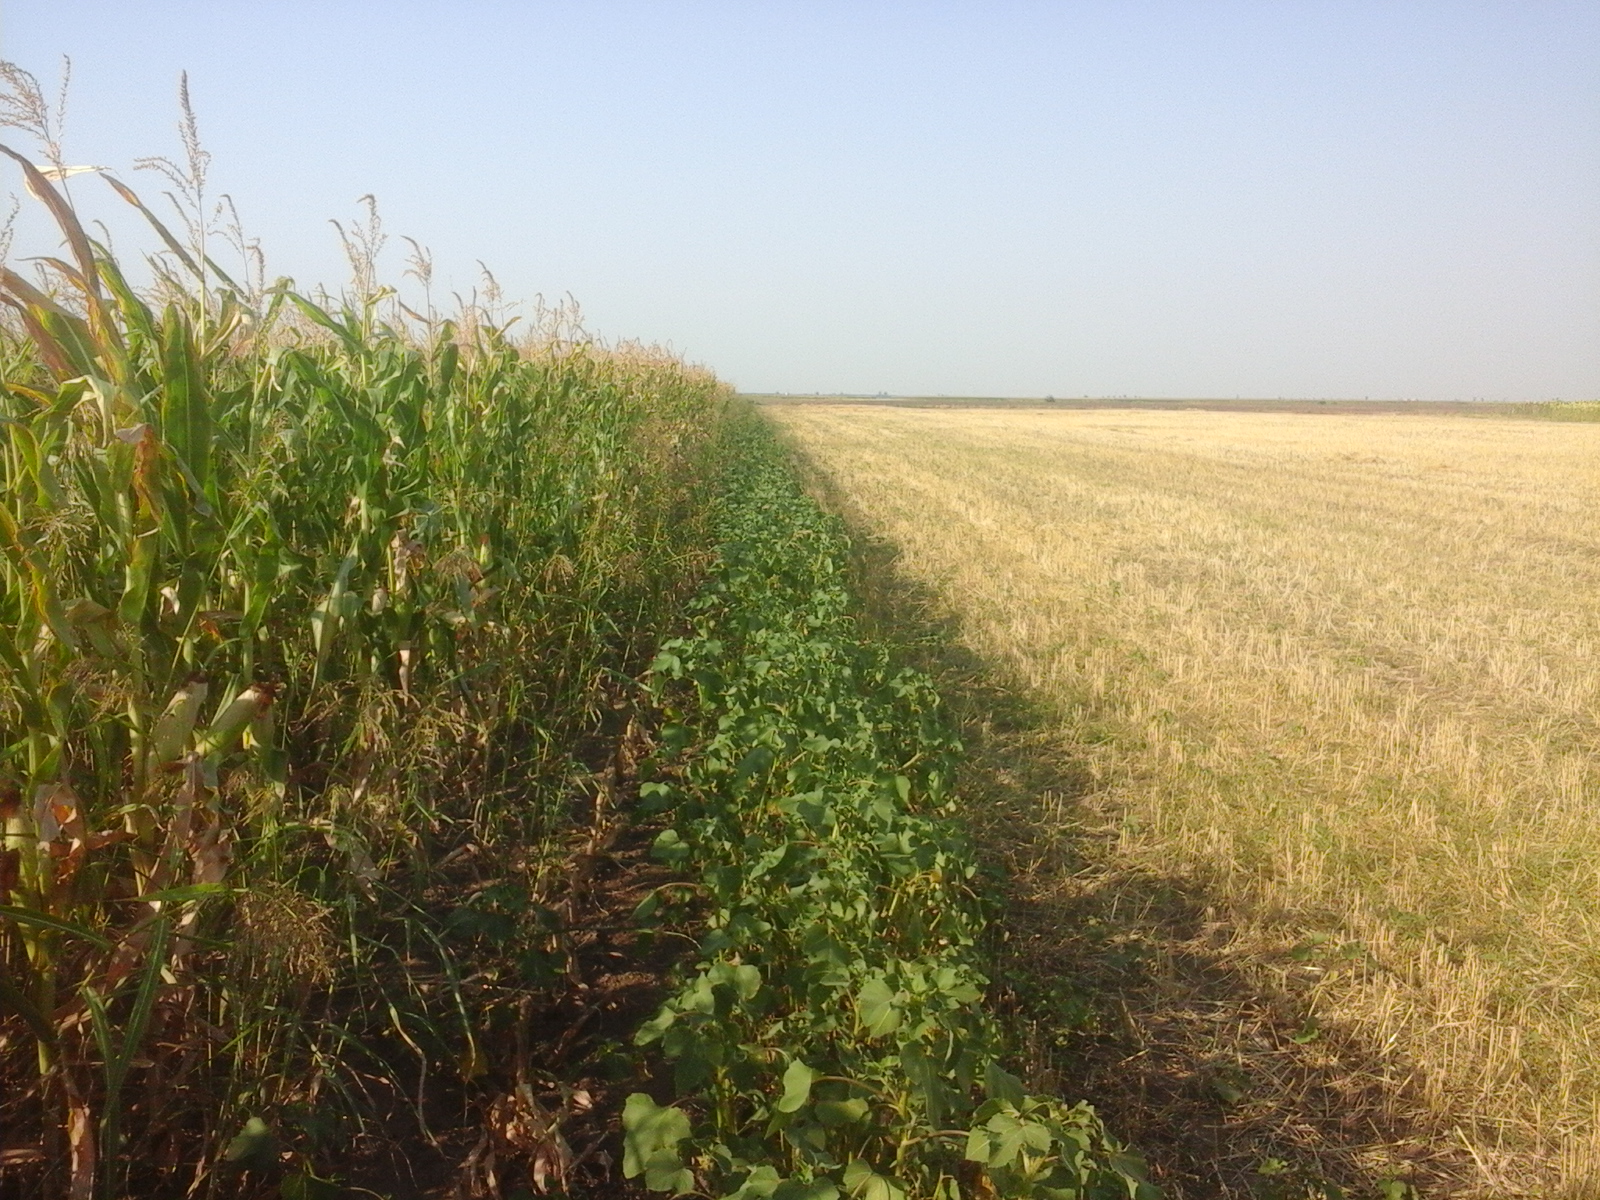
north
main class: Cropland
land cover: Common wheat
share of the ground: > 75 %
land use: Agriculture (excluding fallow land and kitchen gardens)
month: August
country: RO
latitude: 45.0149
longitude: 27.5467
